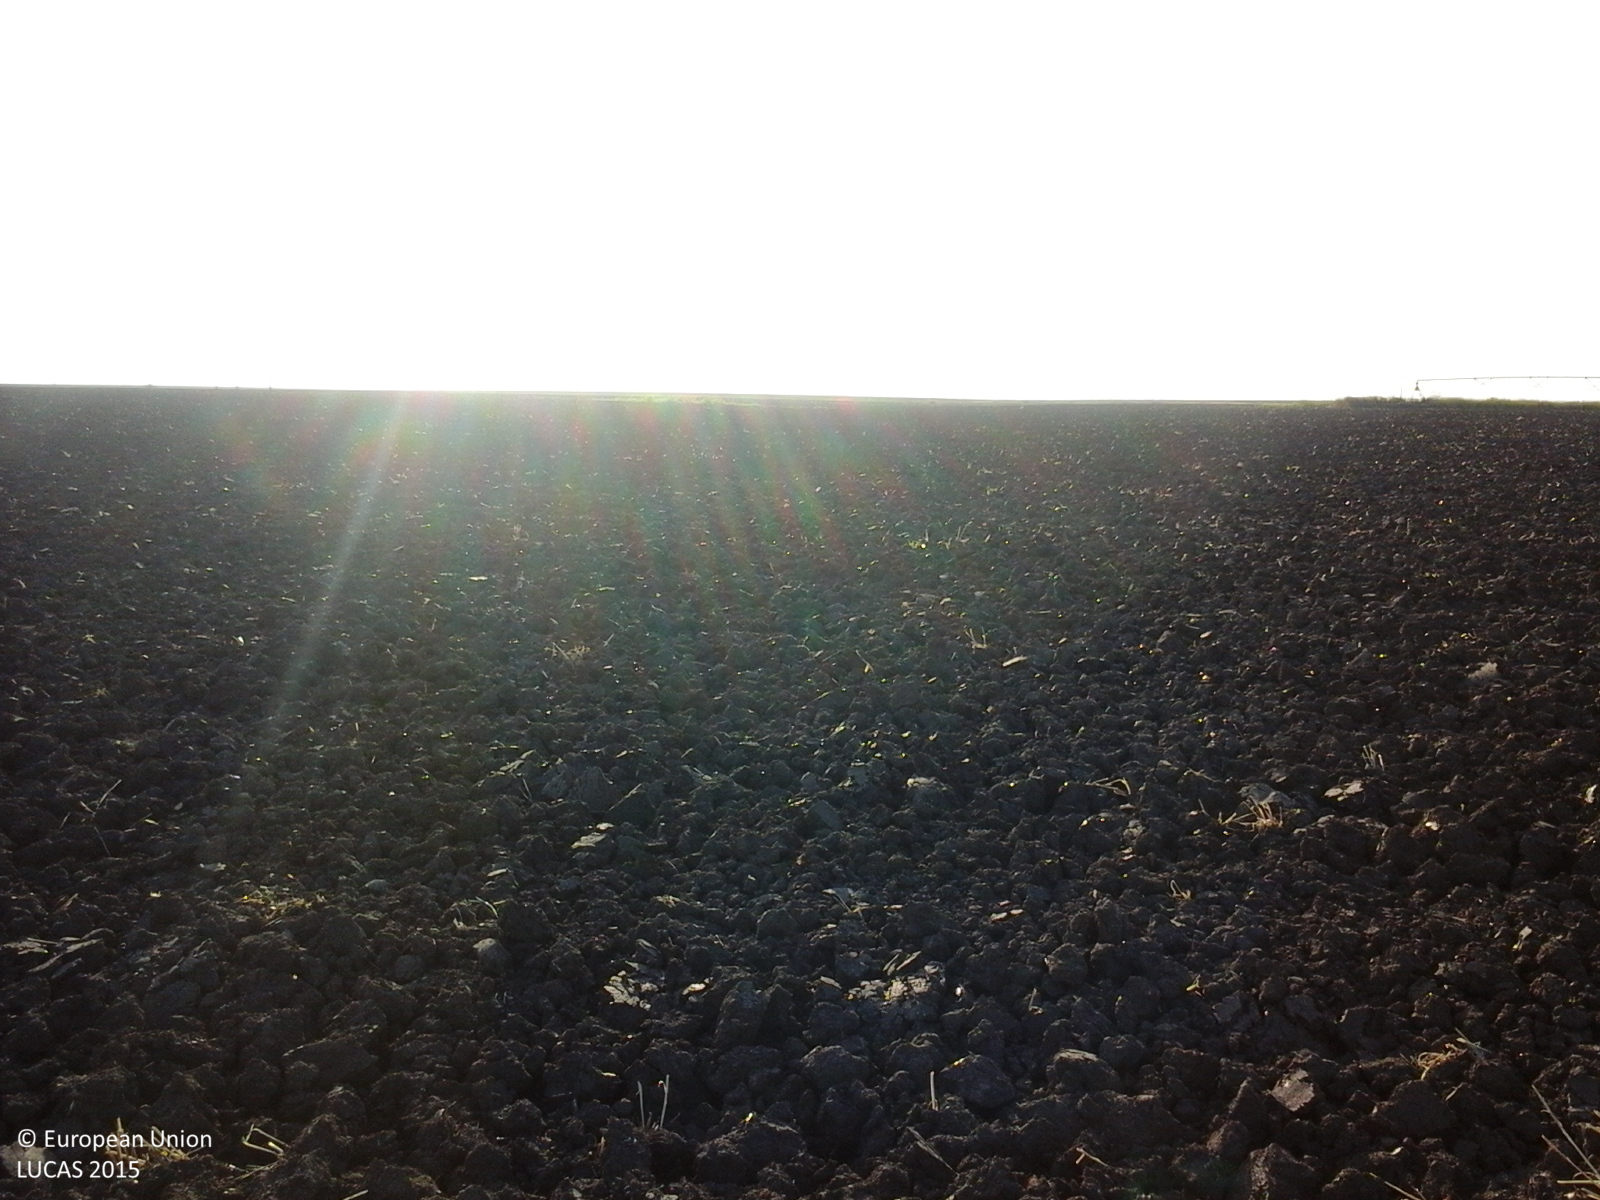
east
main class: Cropland
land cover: Common wheat
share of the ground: < 10 %
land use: Agriculture (excluding fallow land and kitchen gardens)
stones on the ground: < 10 %
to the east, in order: Common wheat
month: August
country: RO
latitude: 44.0344
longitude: 23.7418
